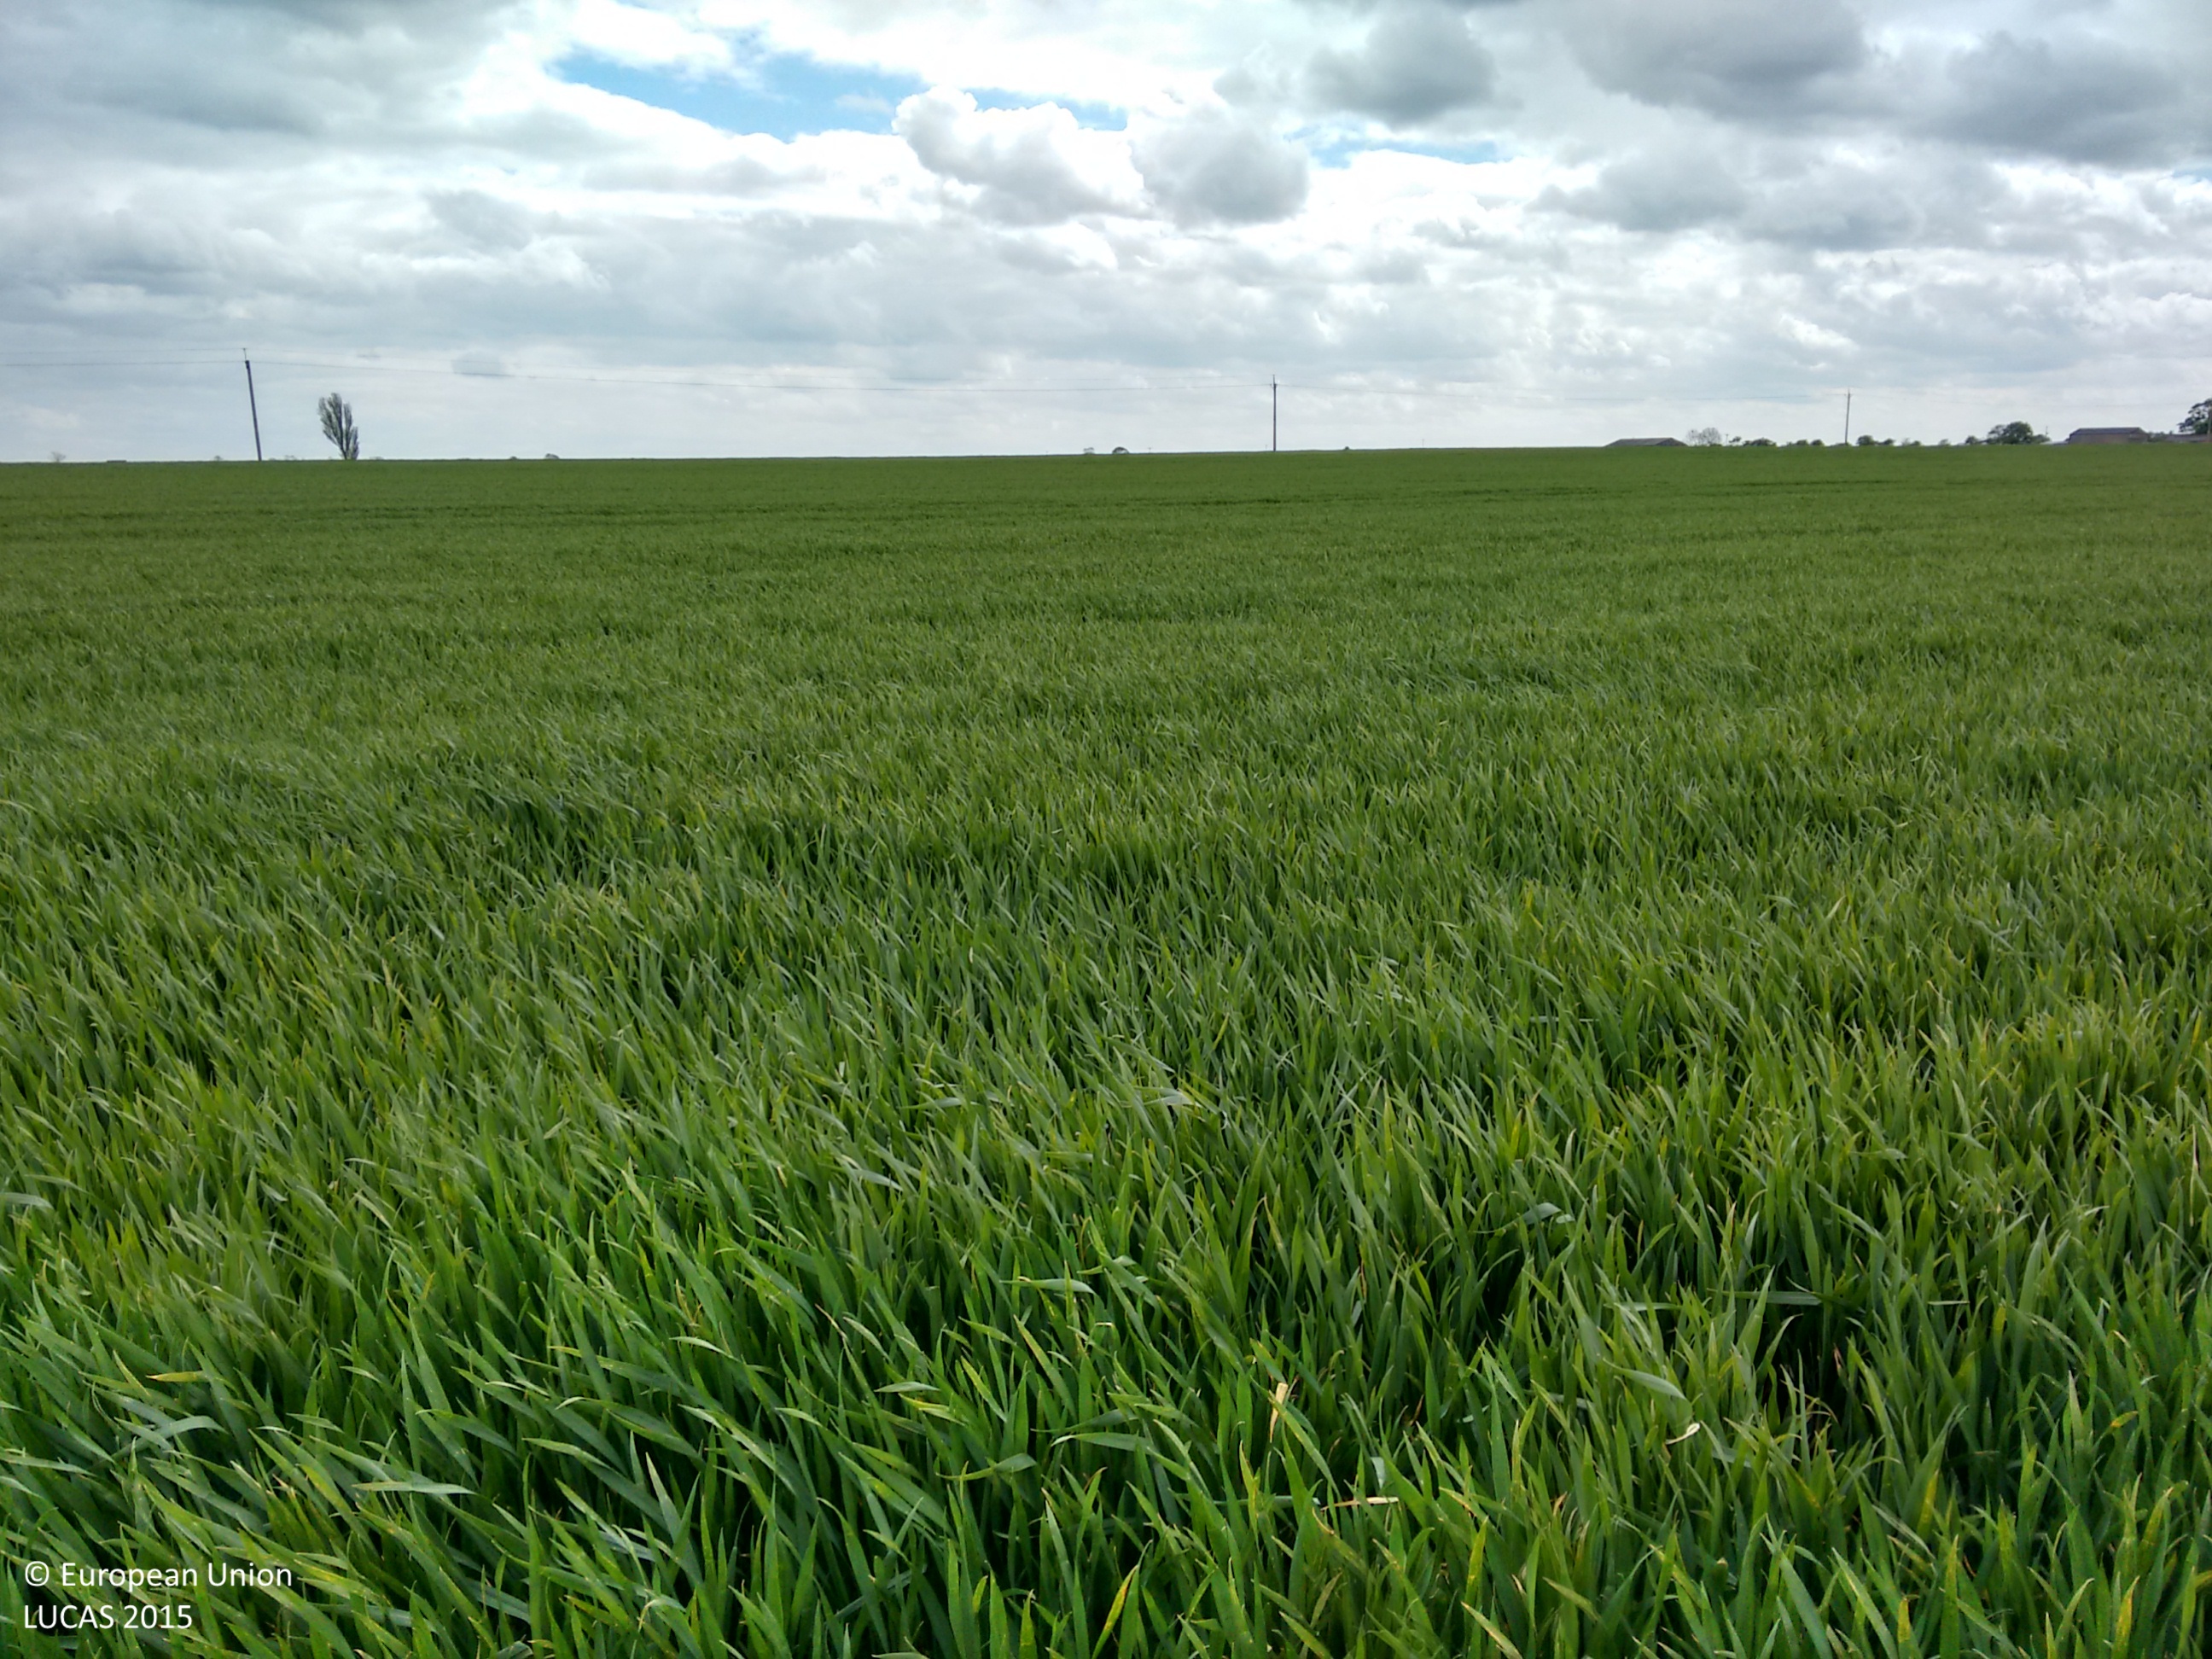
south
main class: Cropland
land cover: Barley
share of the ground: > 75 %
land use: Agriculture (excluding fallow land and kitchen gardens)
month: May
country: GB
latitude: 53.0552
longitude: 0.1674
